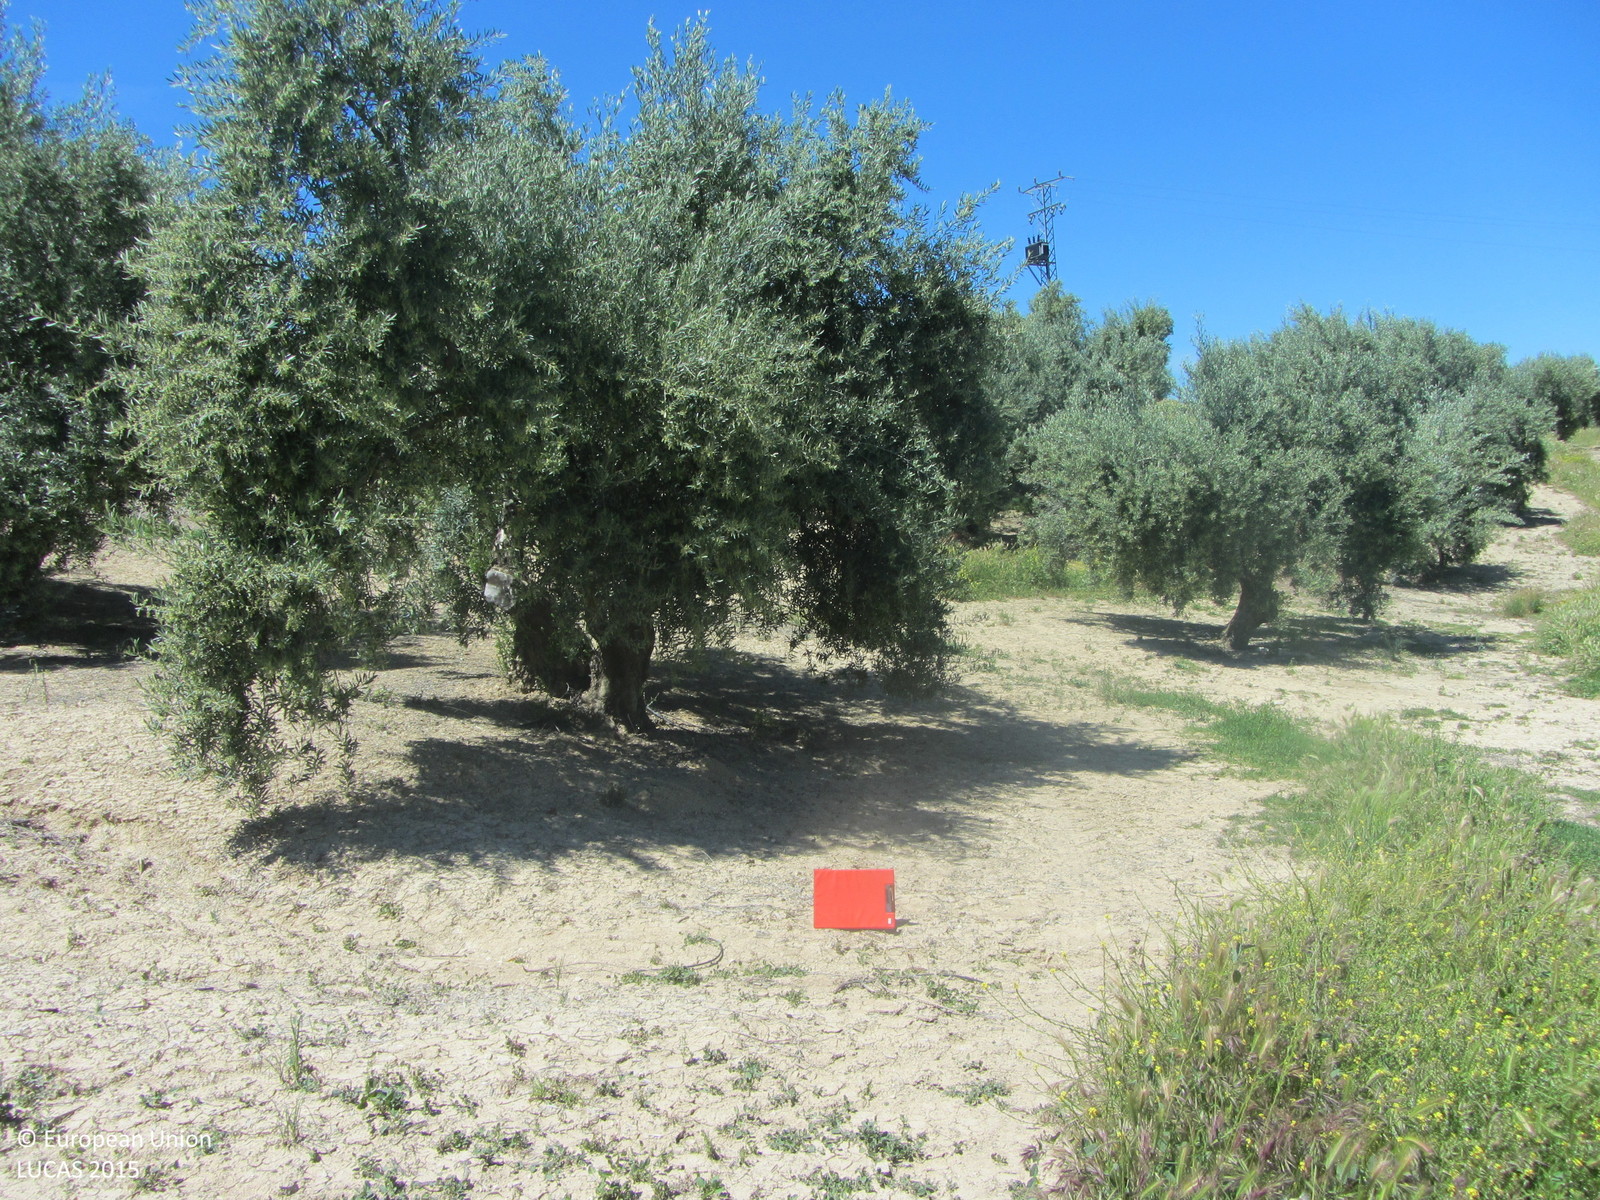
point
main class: Cropland
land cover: Olive groves
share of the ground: 25 - 50 %
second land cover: Spontaneously vegetated surfaces
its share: 25 - 50 %
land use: Agriculture (excluding fallow land and kitchen gardens)
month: May
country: ES
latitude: 38.0906
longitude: -3.0535
